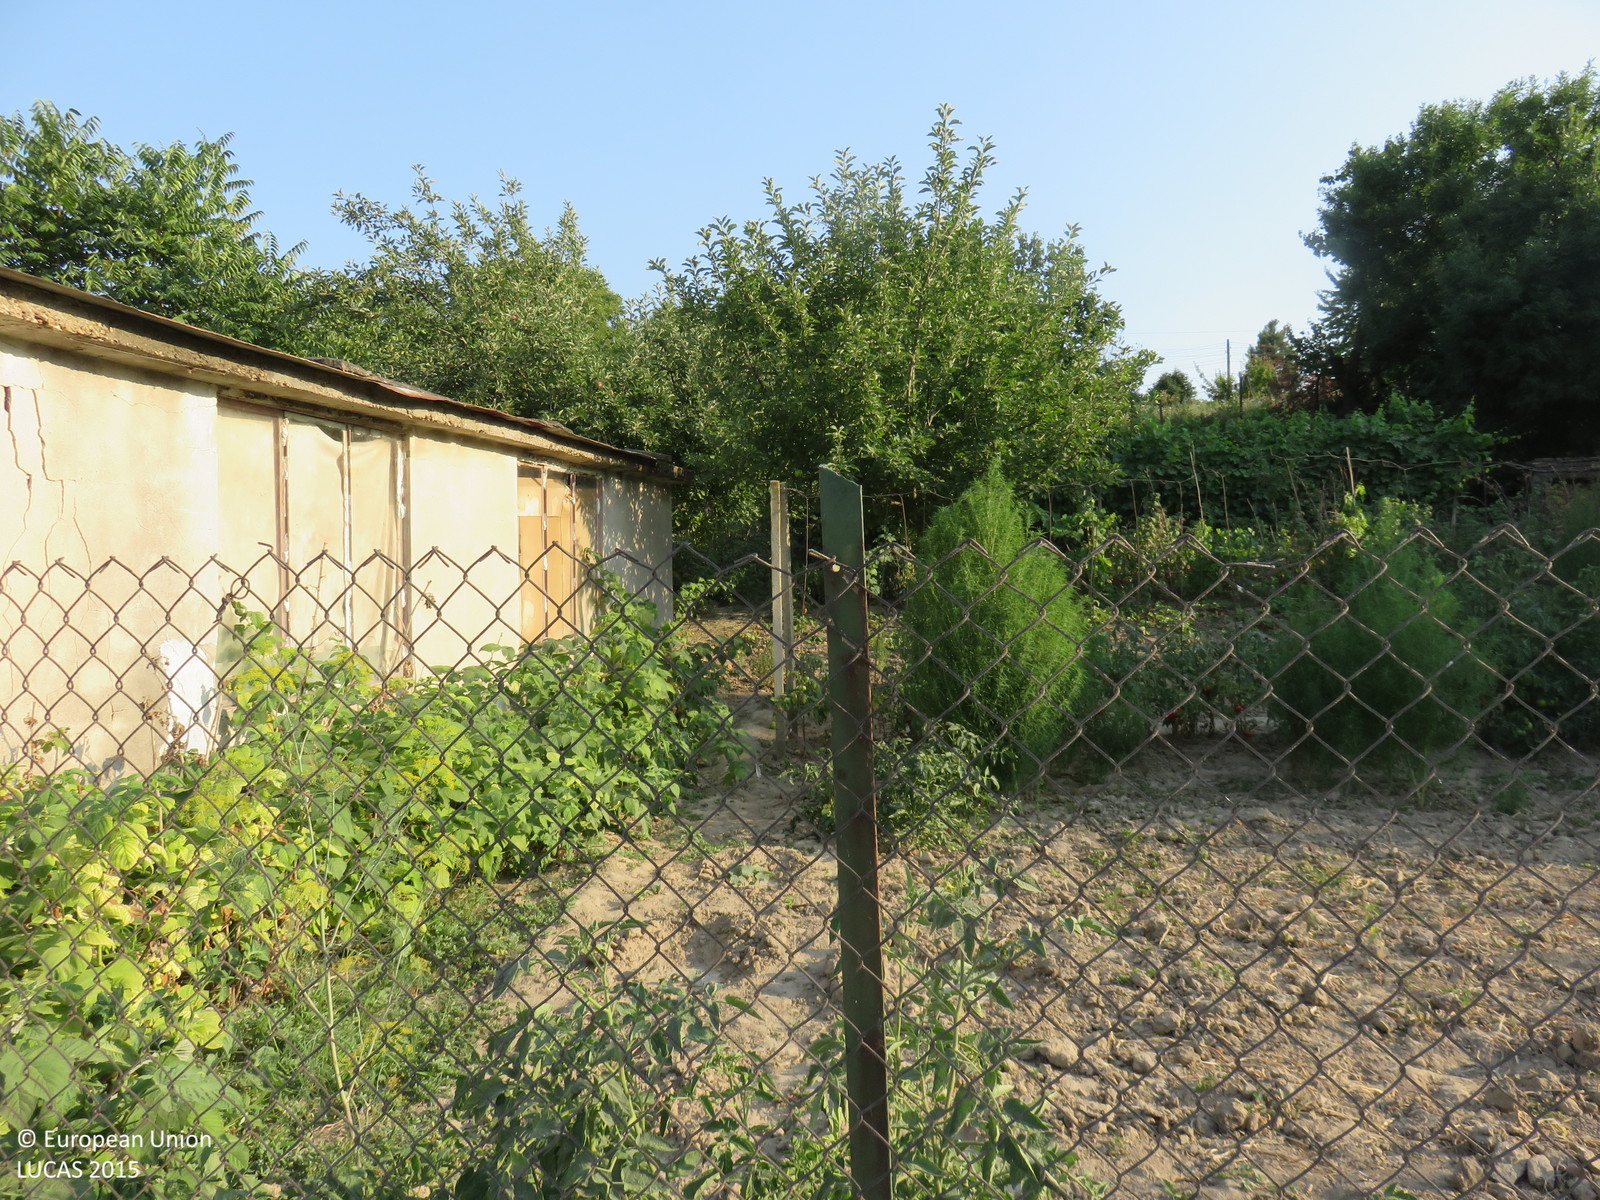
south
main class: Cropland
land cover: Vineyards
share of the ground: 50 - 75 %
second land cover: Other bare soil
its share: > 75 %
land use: Kitchen garden
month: July
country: BG
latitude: 43.6327
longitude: 25.0336
